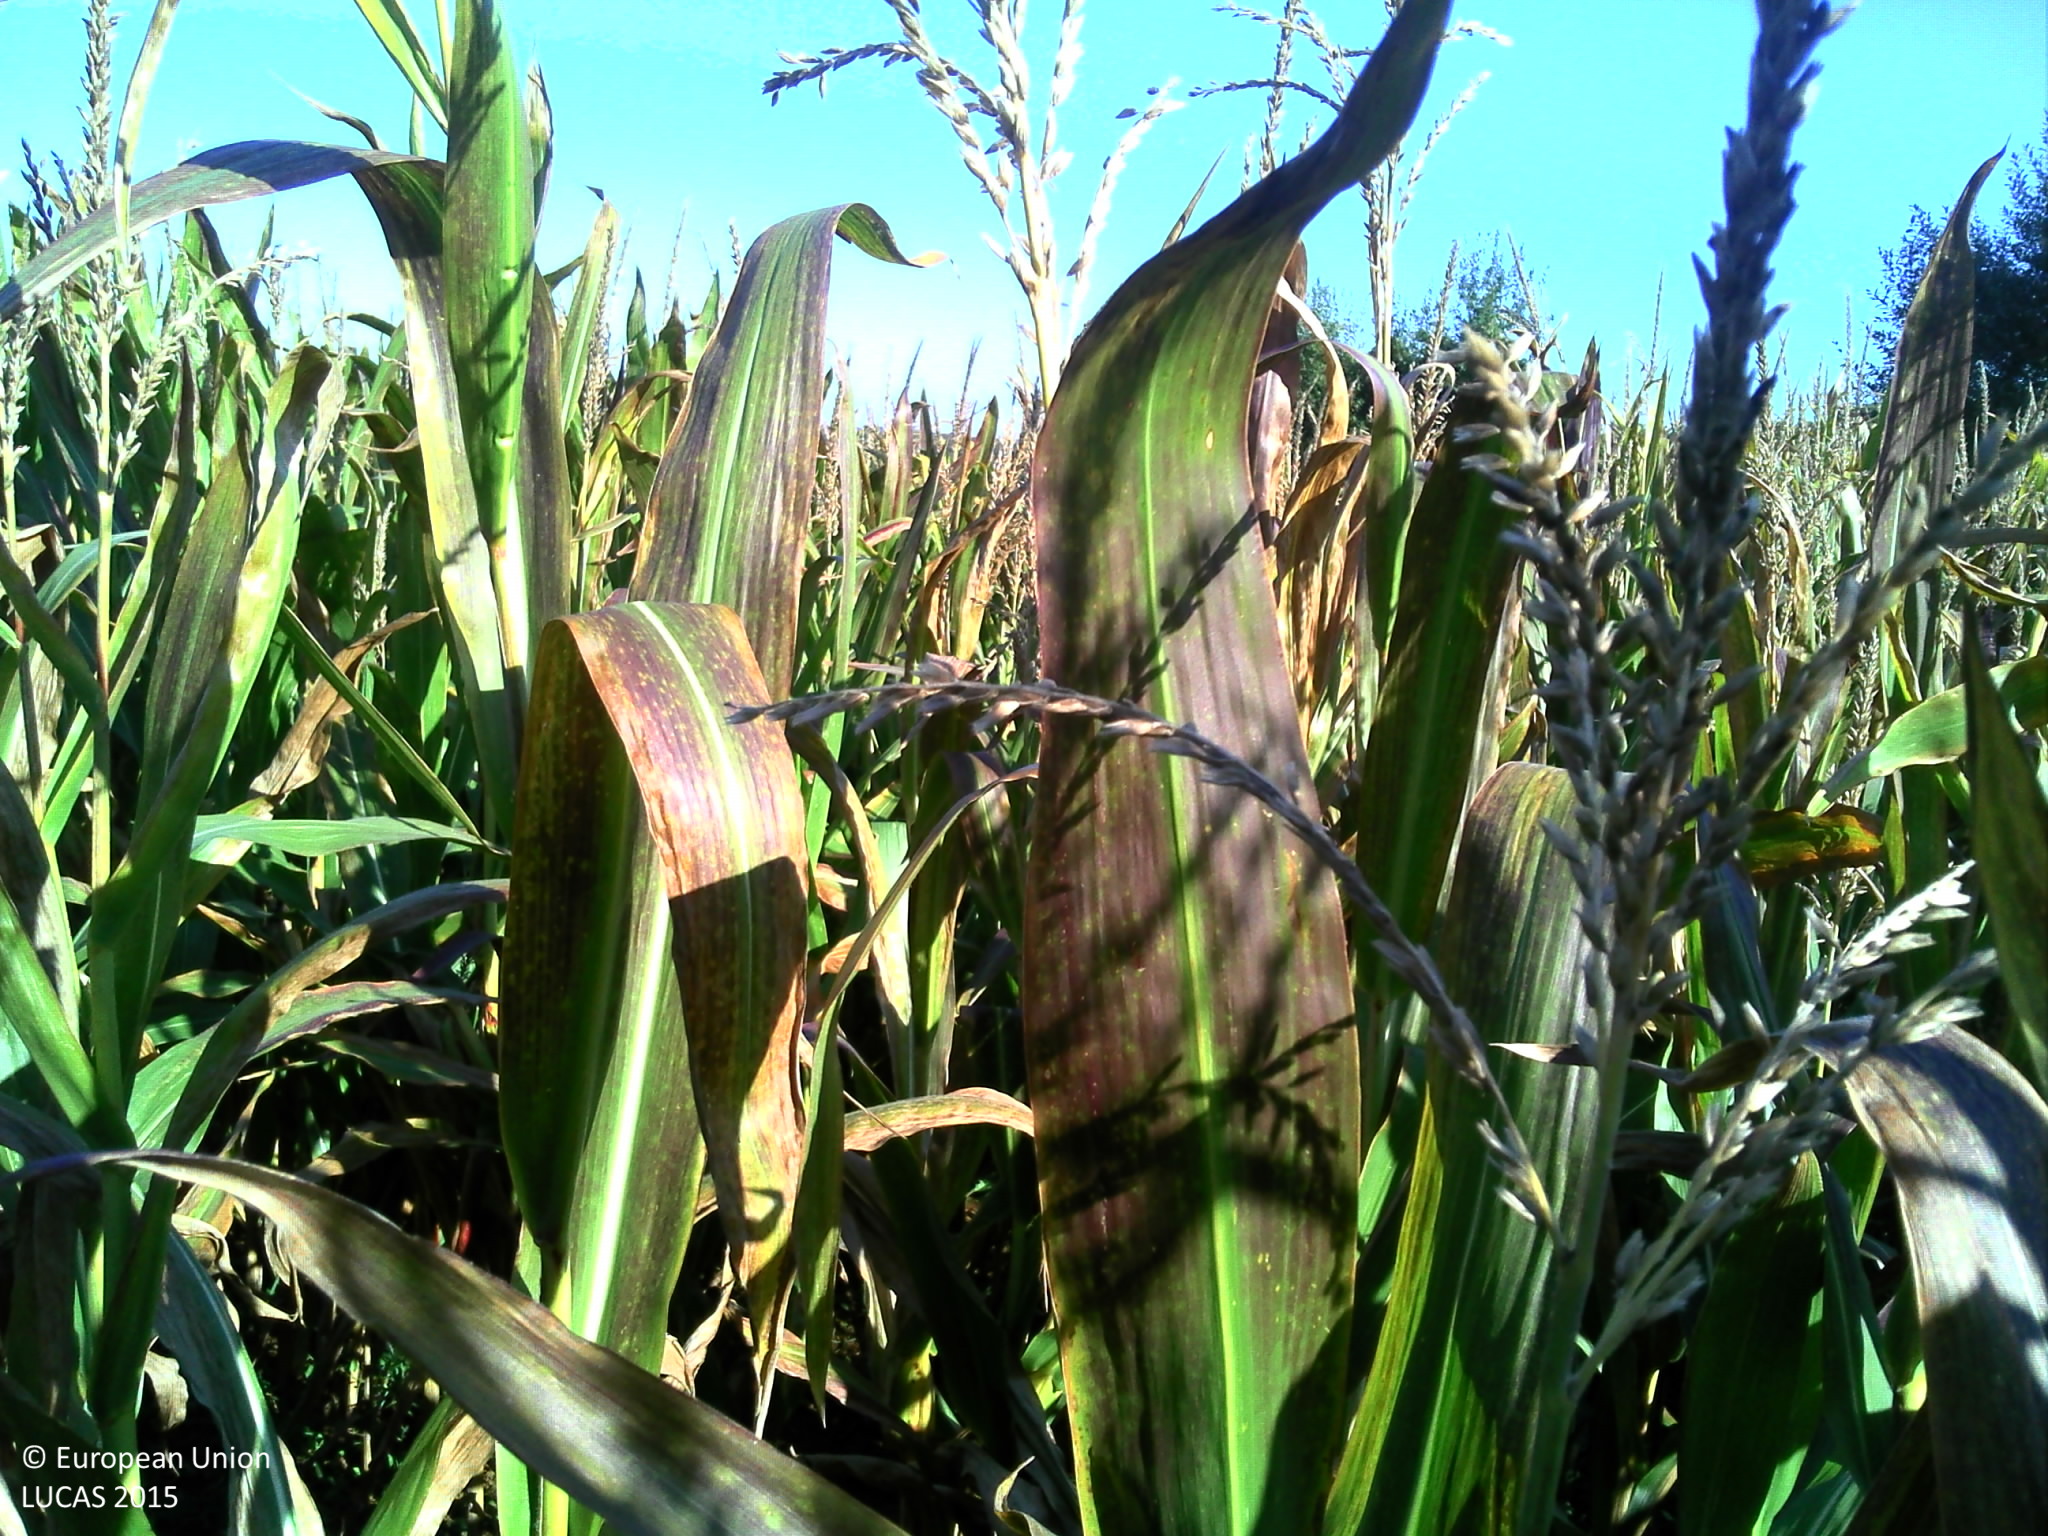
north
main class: Cropland
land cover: Maize
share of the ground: > 75 %
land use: Agriculture (excluding fallow land and kitchen gardens)
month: September
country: FR
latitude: 49.3008
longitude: 5.9149
